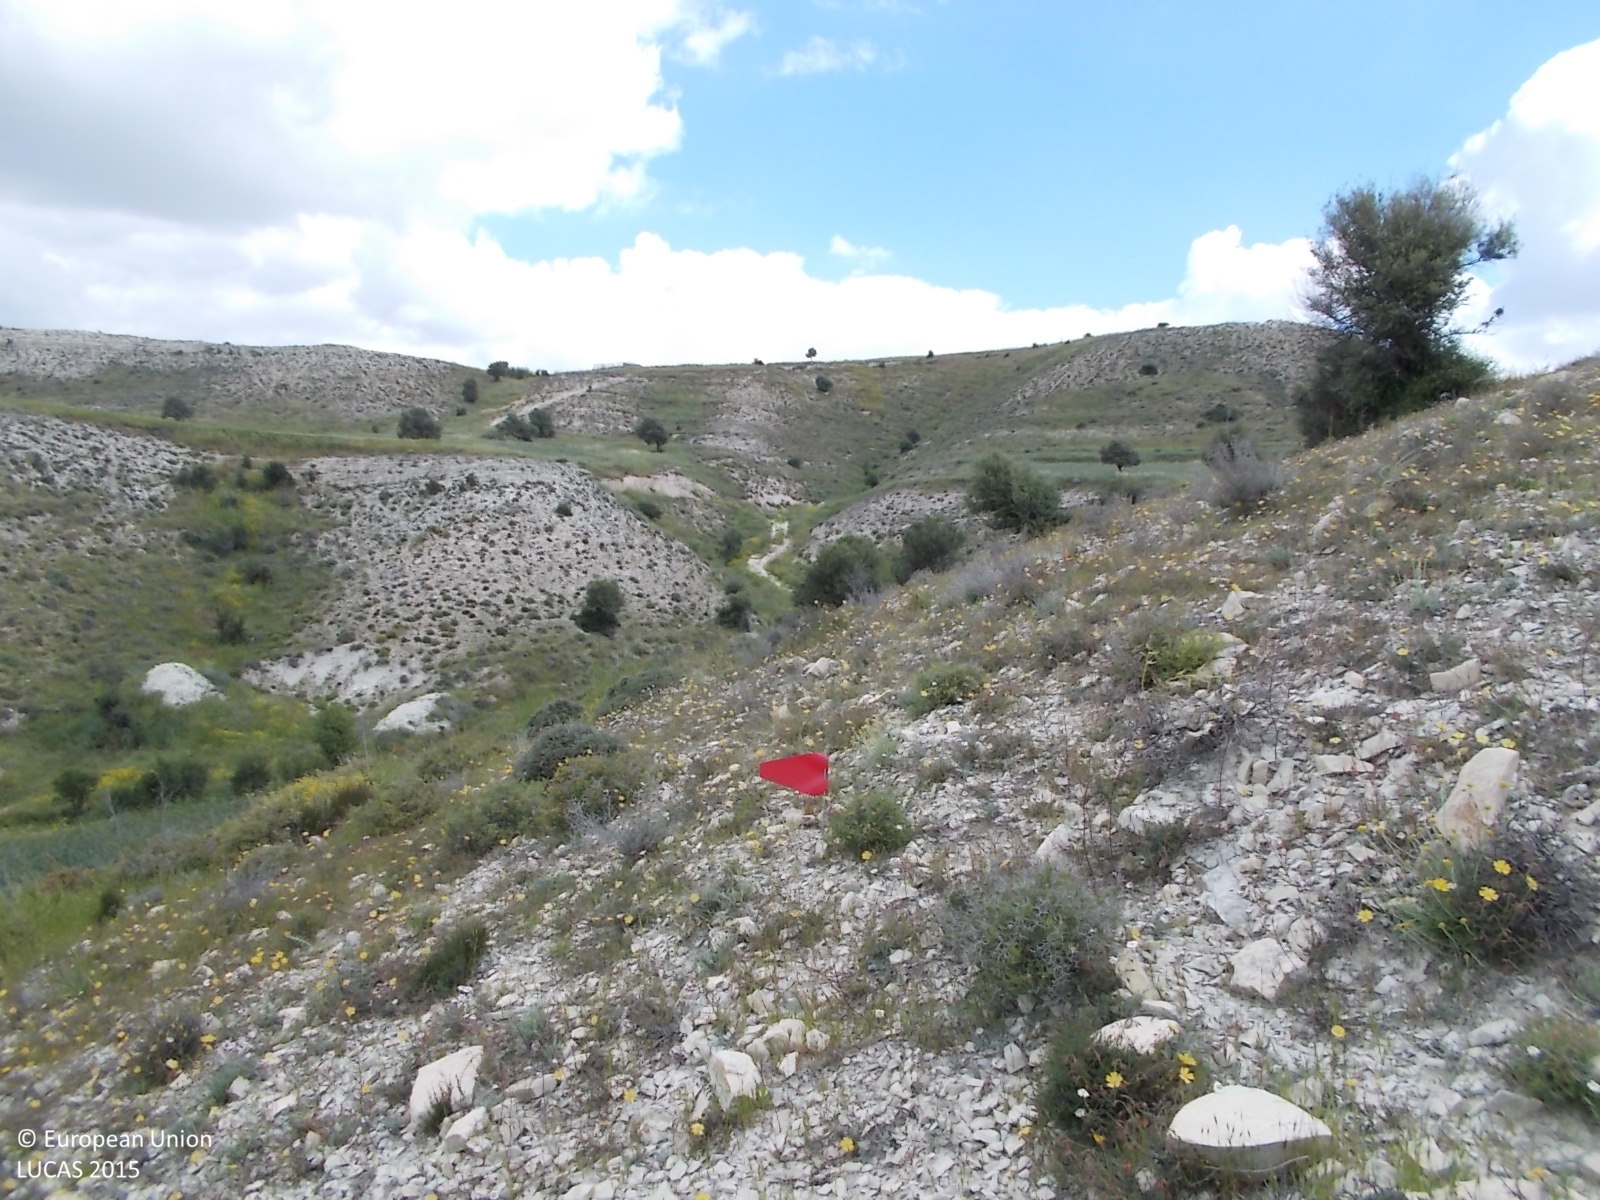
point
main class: Shrubland
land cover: Shrubland without tree cover
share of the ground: 25 - 50 %
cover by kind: unconsolidated bare surface 60 %, shrubs 40 %
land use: Semi-natural and natural areas not in use
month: April
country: CY
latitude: 34.9735
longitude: 33.4673
